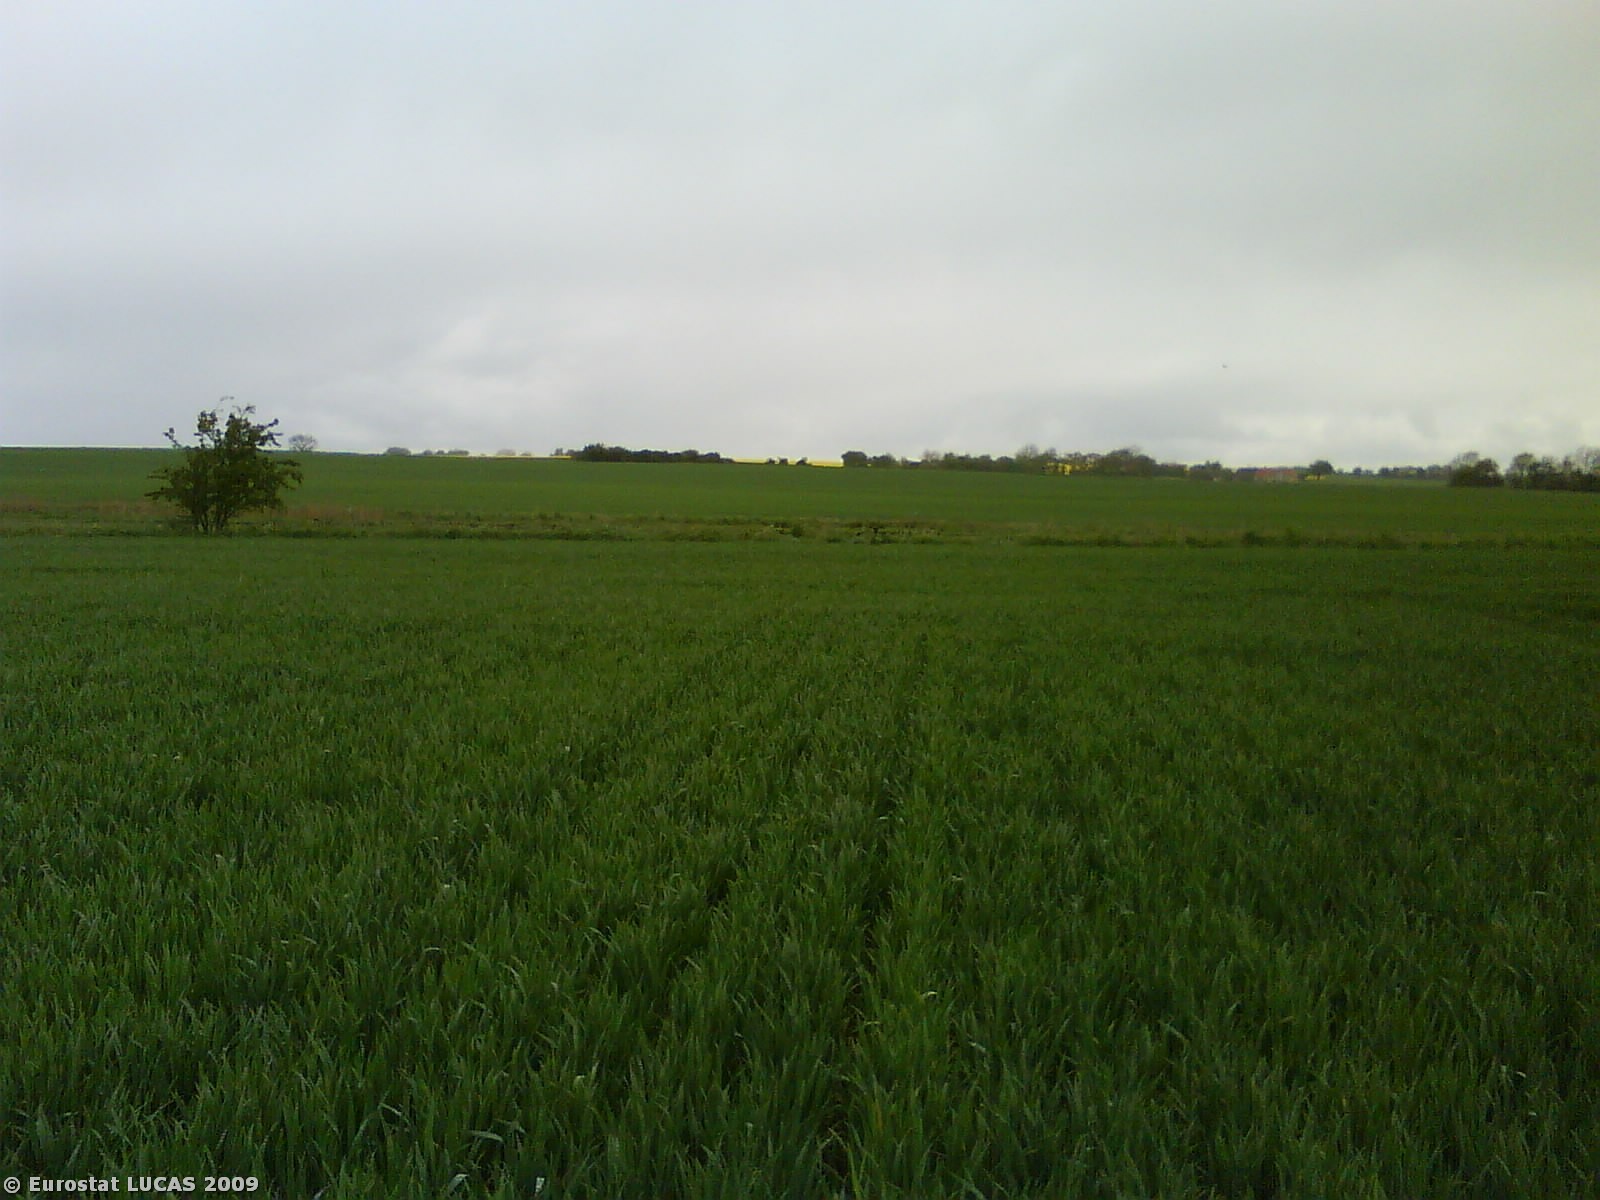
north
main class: Cropland
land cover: Common wheat
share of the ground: > 75 %
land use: Agriculture (excluding fallow land and kitchen gardens)
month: May
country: DK
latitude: 56.3674
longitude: 10.1455
